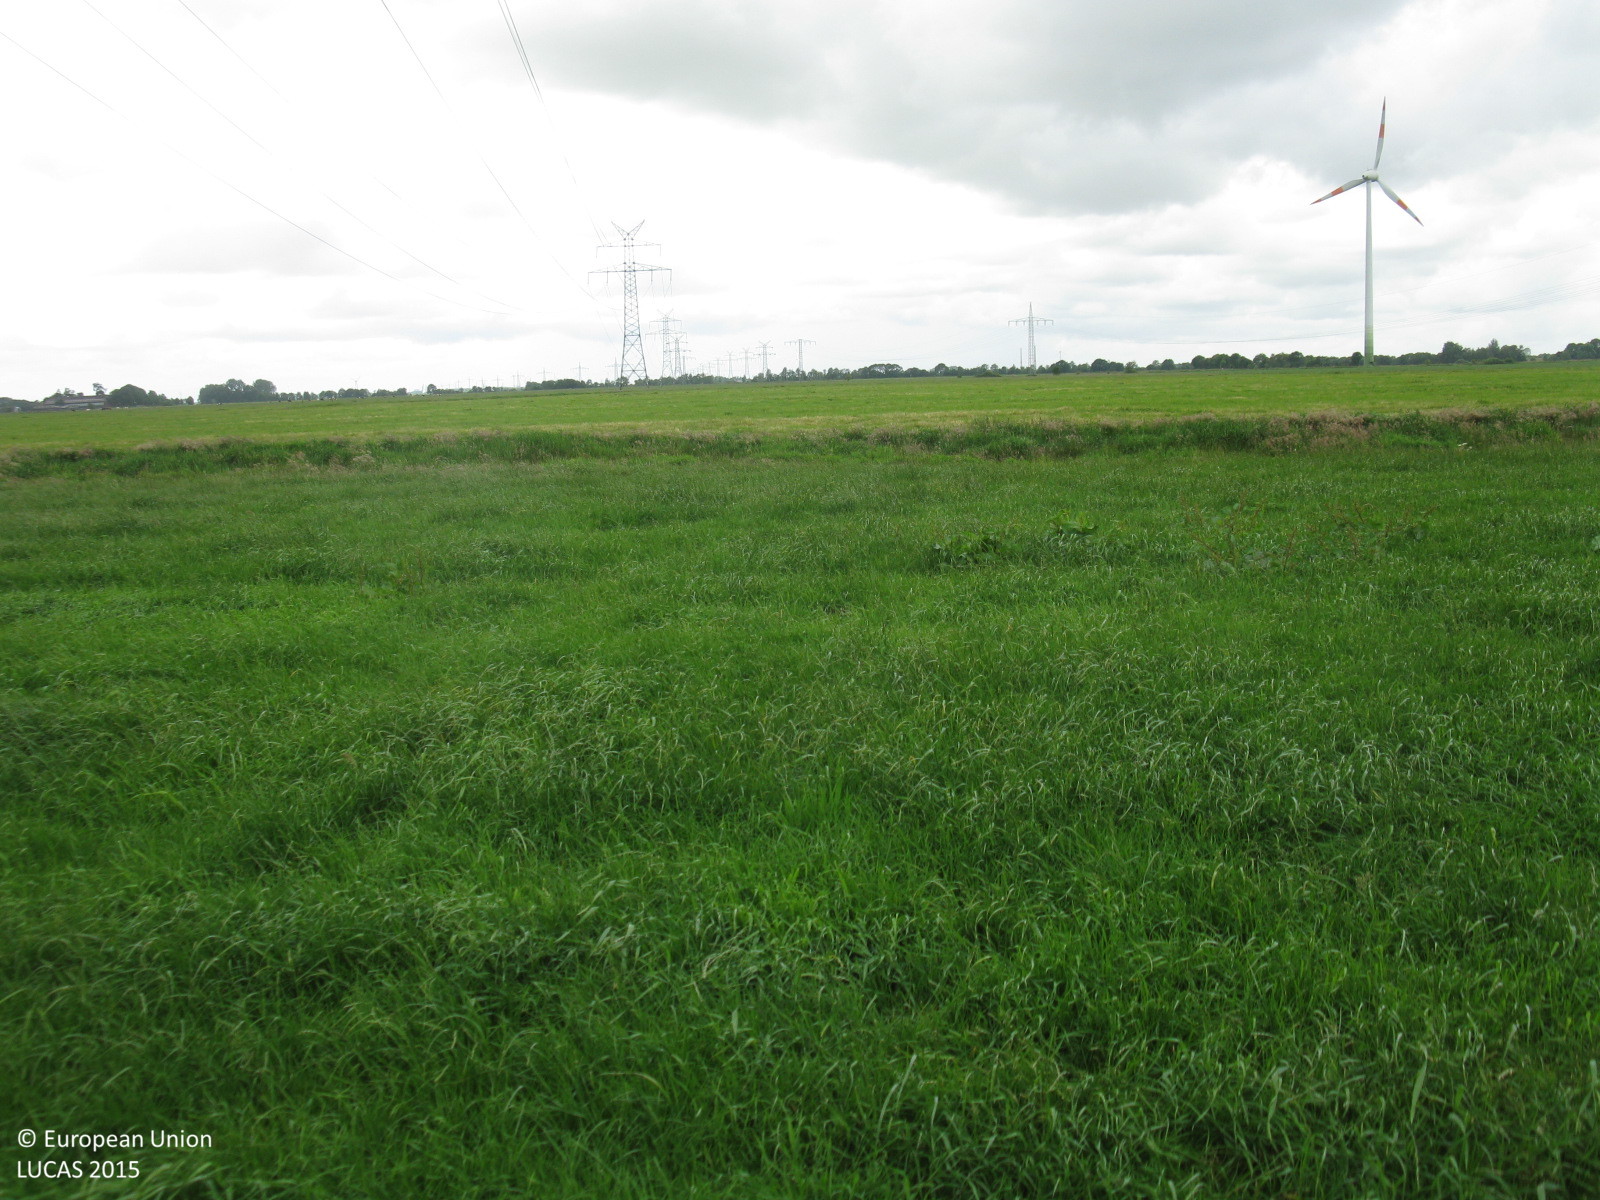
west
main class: Grassland
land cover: Grassland without tree/shrub cover
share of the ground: > 75 %
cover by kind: herbaceous plants 100 %
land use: Agriculture (excluding fallow land and kitchen gardens)
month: June
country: DE
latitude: 53.3554
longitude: 7.3713
